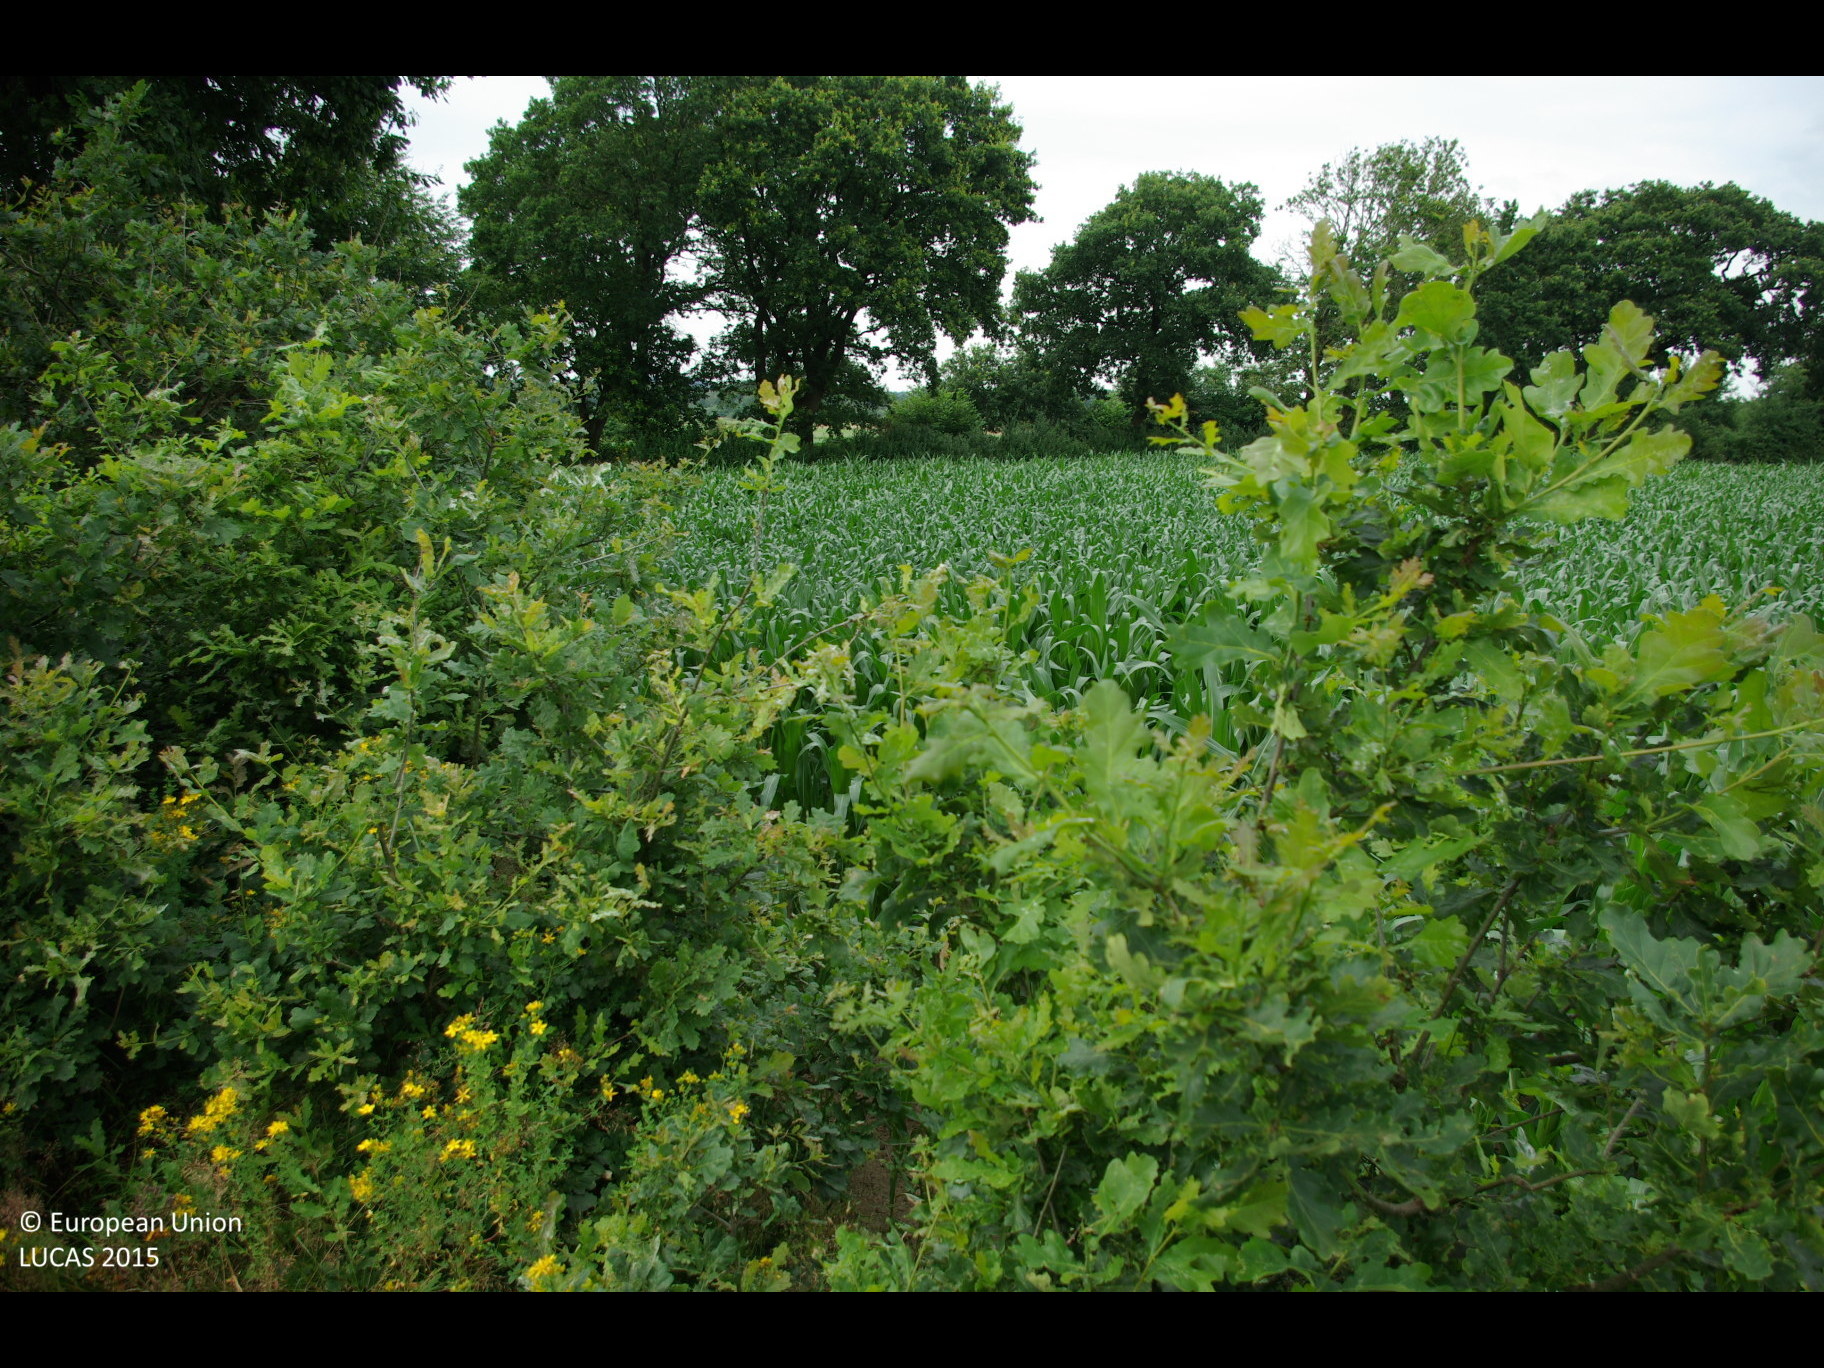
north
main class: Cropland
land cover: Maize
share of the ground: > 75 %
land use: Agriculture (excluding fallow land and kitchen gardens)
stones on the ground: 25 - 50 %
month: July
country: DE
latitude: 54.2267
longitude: 9.3102
